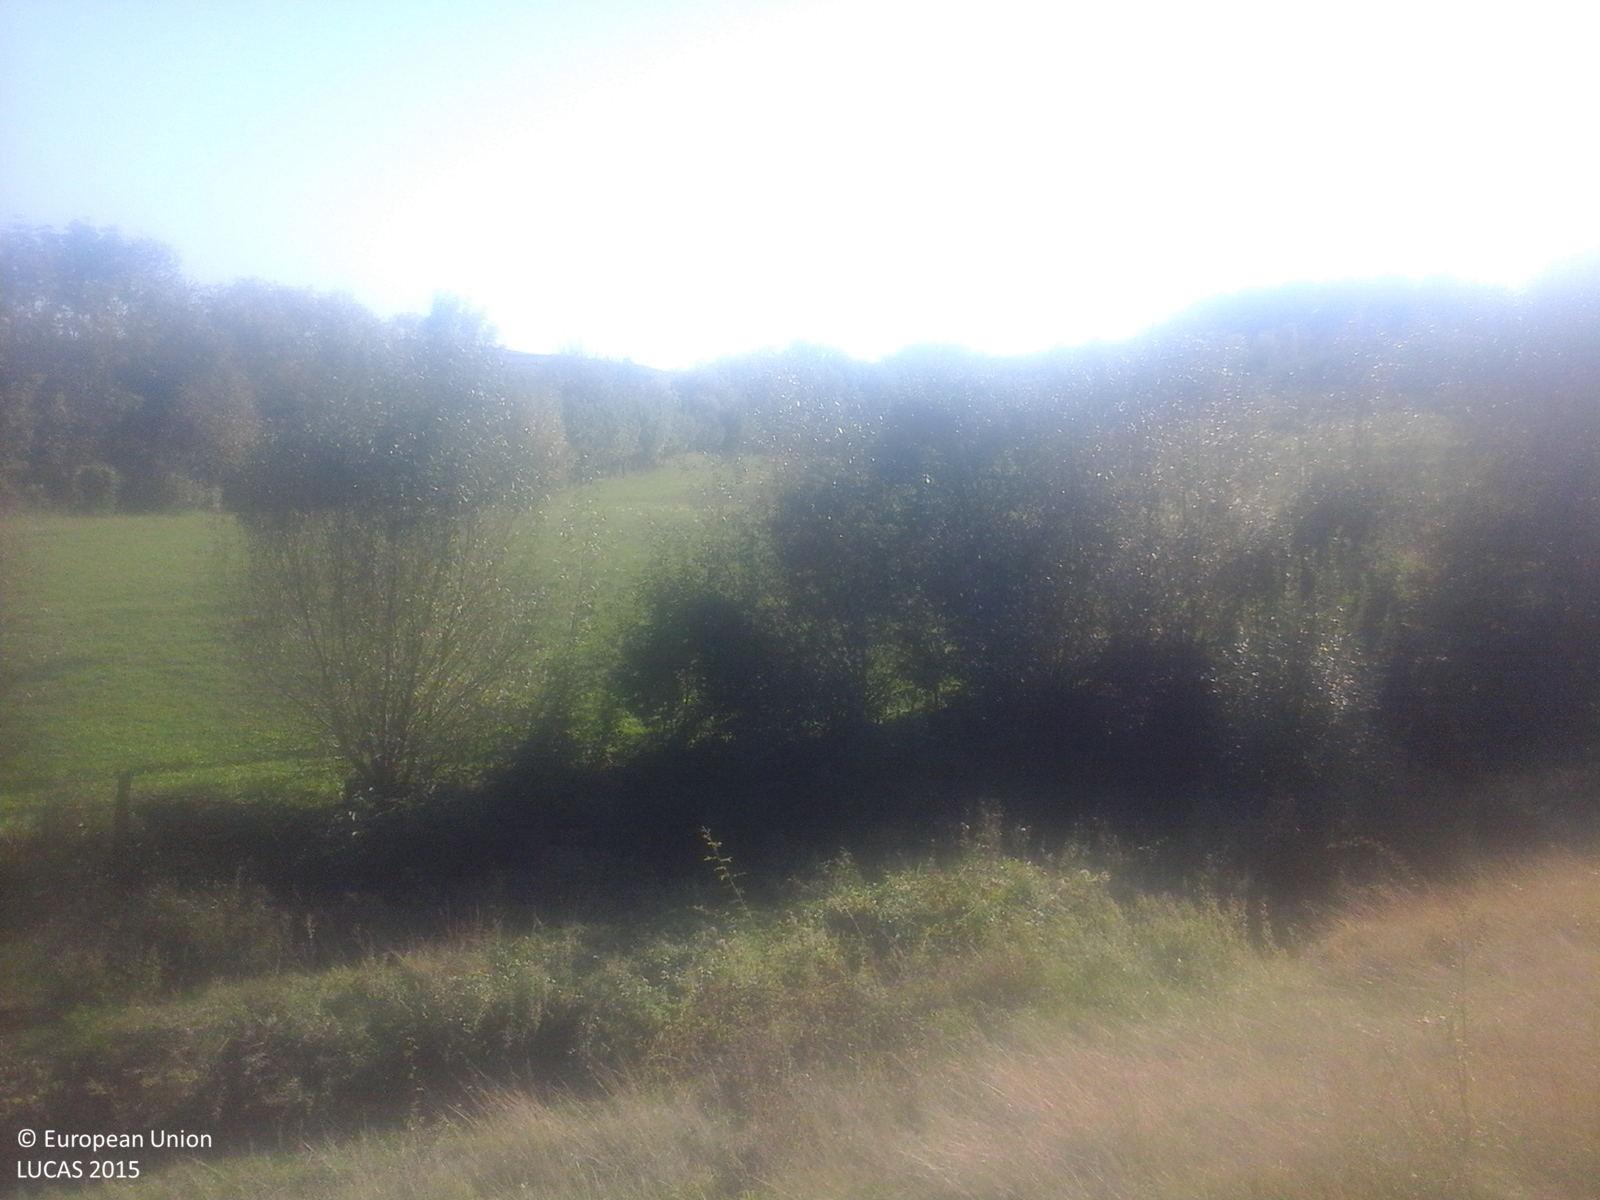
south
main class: Grassland
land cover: Grassland with sparse tree/shrub cover
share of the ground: > 75 %
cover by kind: herbaceous plants 85 %, shrubs 10 %, broadleaved forest trees 5 %
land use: Agriculture (excluding fallow land and kitchen gardens)
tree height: < 5 m
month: October
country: RO
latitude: 46.4603
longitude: 23.6243
